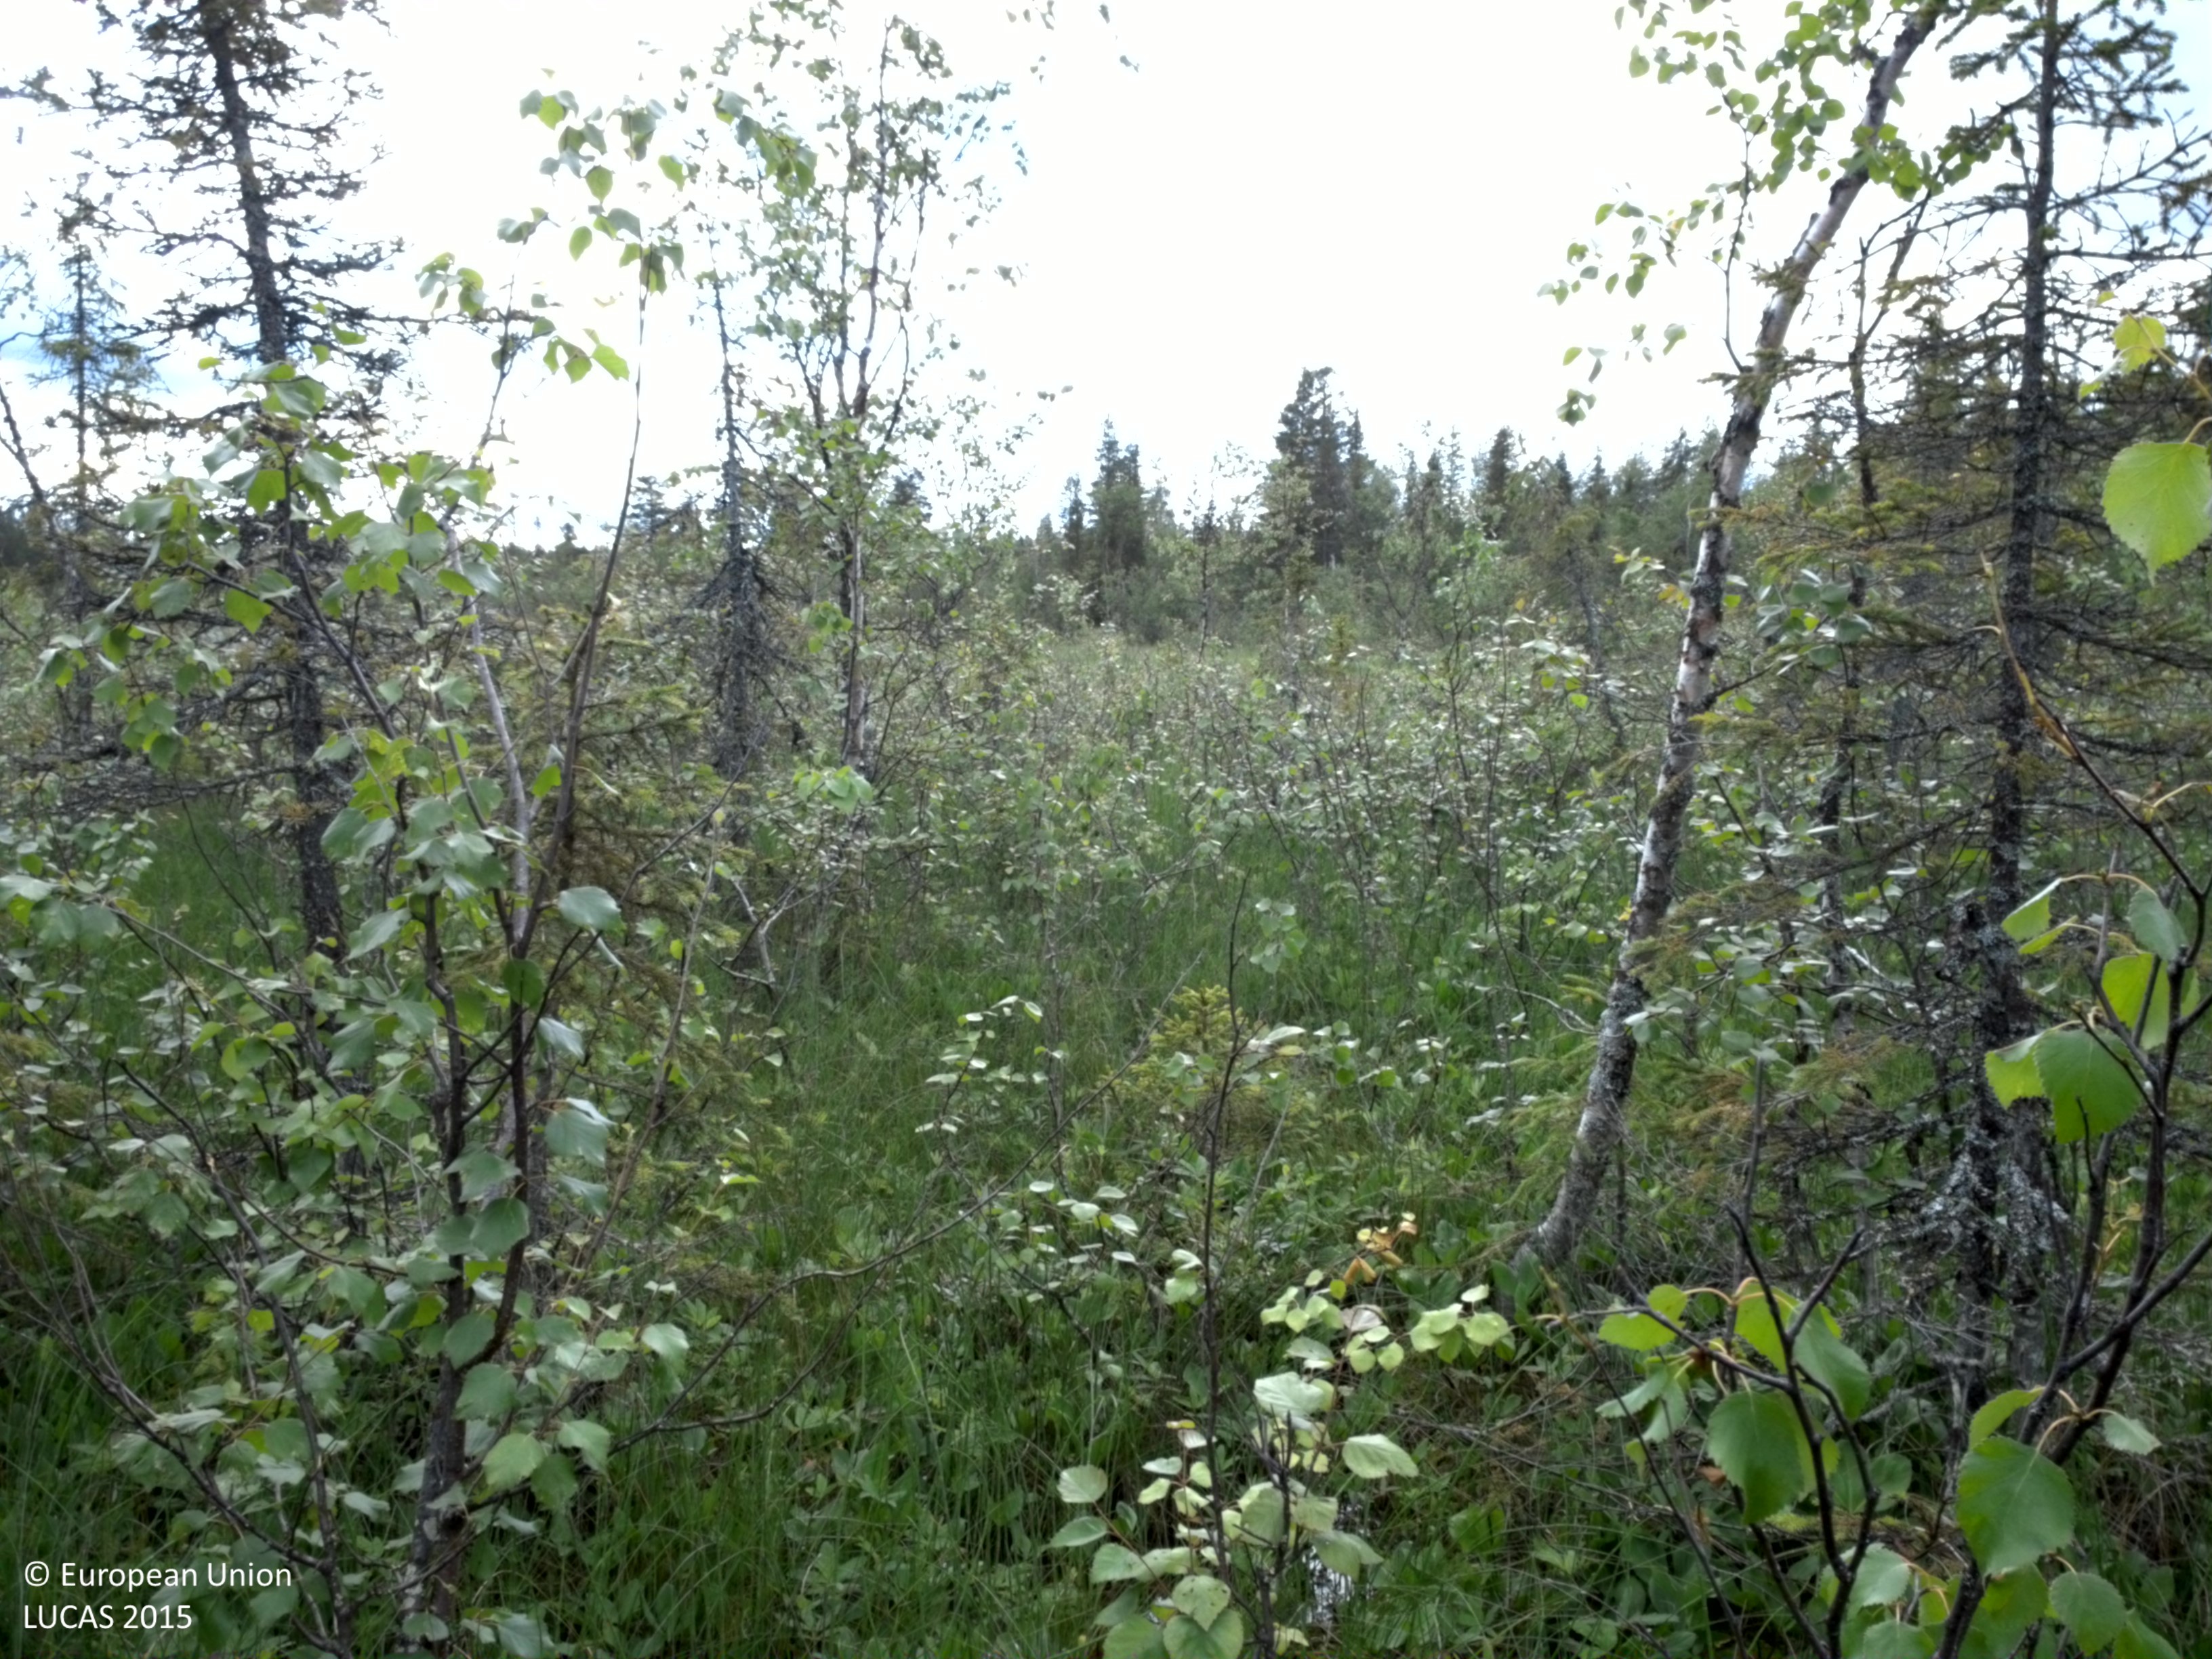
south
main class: Woodland
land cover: Broadleaved woodland
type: mire and swamp forests
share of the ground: 25 - 50 %
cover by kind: herbaceous plants 45 %, broadleaved forest trees 30 %, shrubs 10 %, coniferous forest trees 5 %
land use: Semi-natural and natural areas not in use
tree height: < 5 m
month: August
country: SE
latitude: 66.5139
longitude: 20.8187
